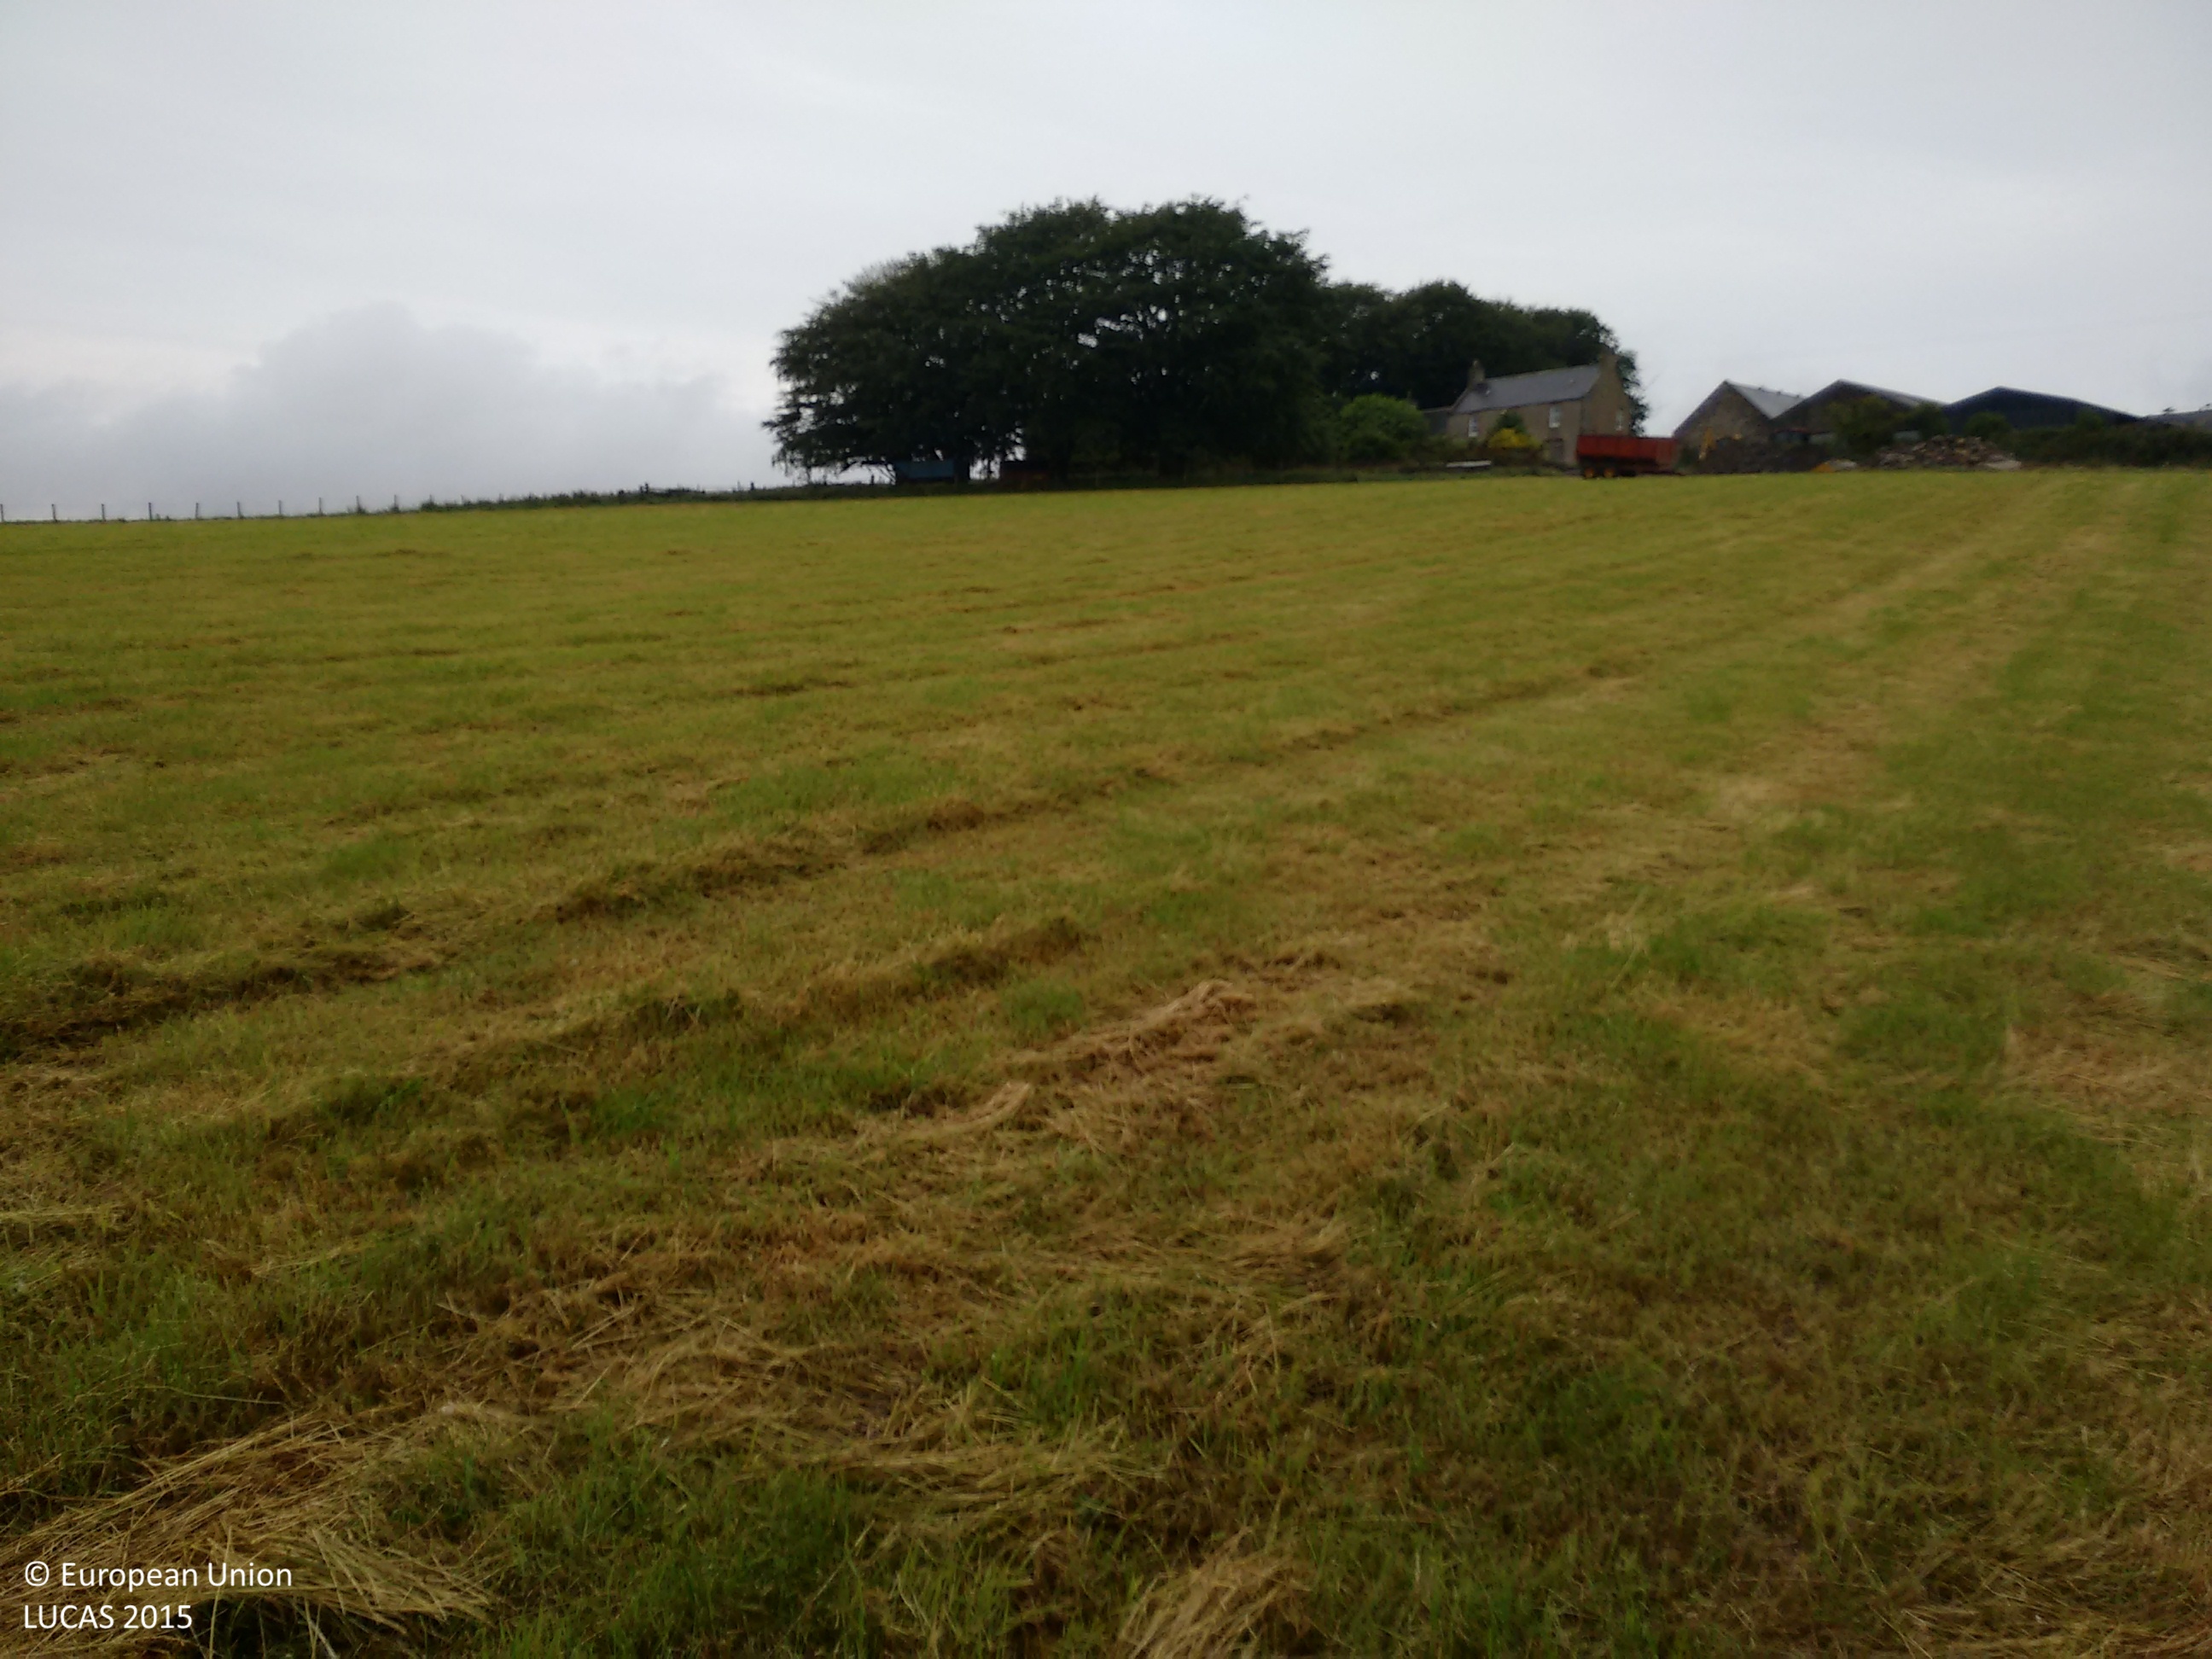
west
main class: Cropland
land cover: Temporary grasslands
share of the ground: > 75 %
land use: Agriculture (excluding fallow land and kitchen gardens)
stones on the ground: < 10 %
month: August
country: GB
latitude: 57.5279
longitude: -2.8336
